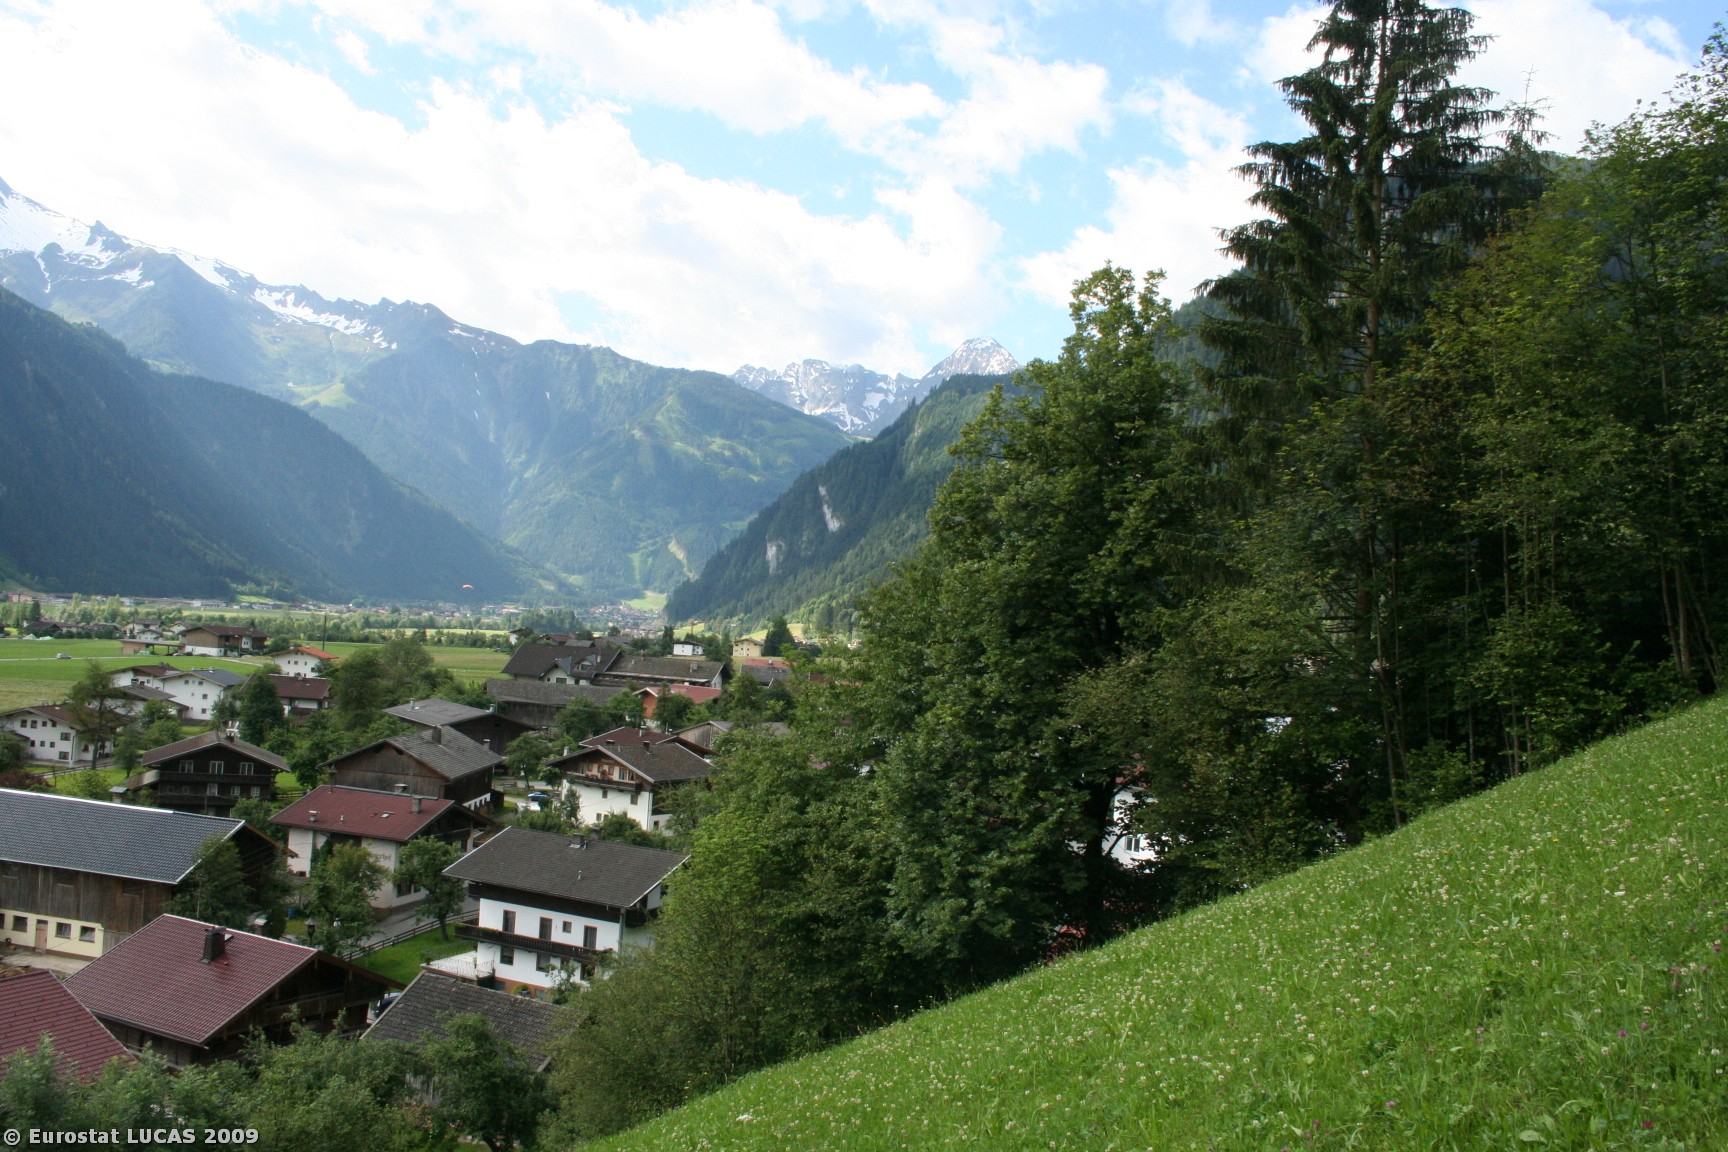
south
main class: Grassland
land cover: Grassland without tree/shrub cover
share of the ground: > 75 %
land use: Agriculture (excluding fallow land and kitchen gardens)
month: June
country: AT
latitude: 47.1996
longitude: 11.8596
